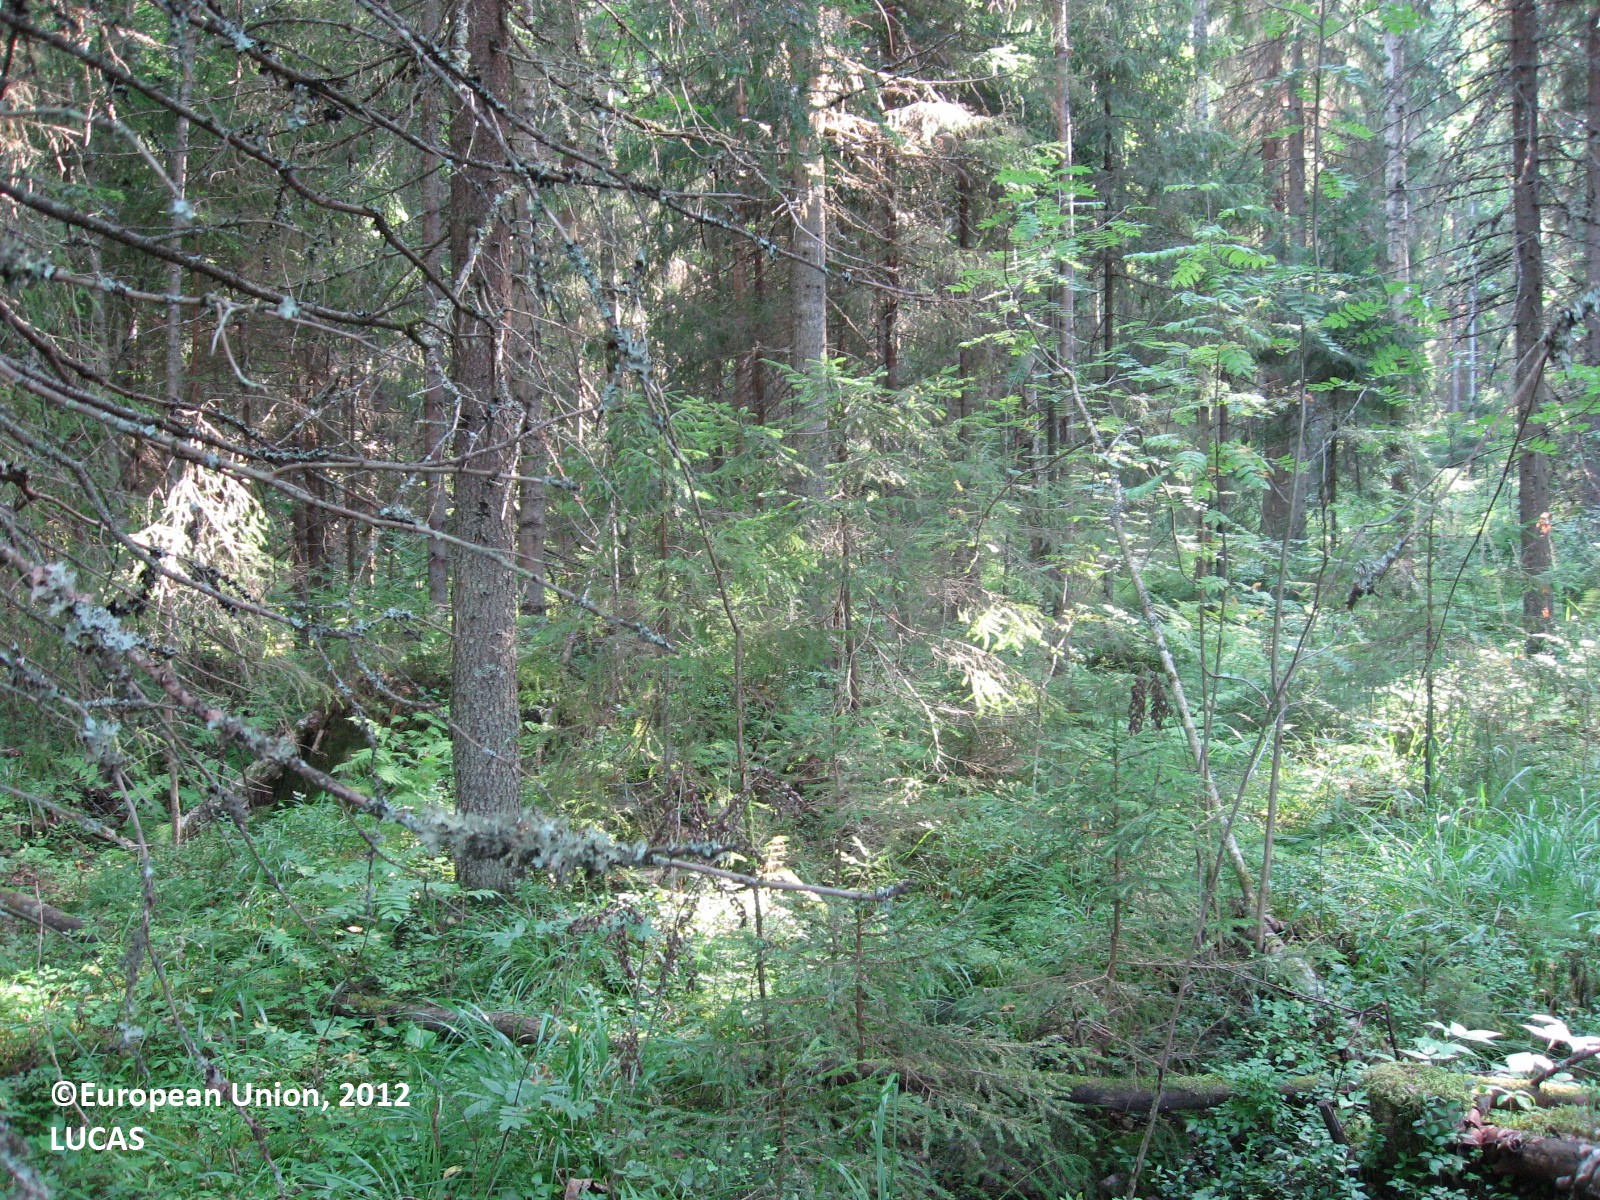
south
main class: Woodland
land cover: Spruce dominated mixed woodland
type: boreal forest
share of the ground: > 75 %
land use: Forestry
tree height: > 5 m
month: August
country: FI
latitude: 61.5176
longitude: 25.0544
